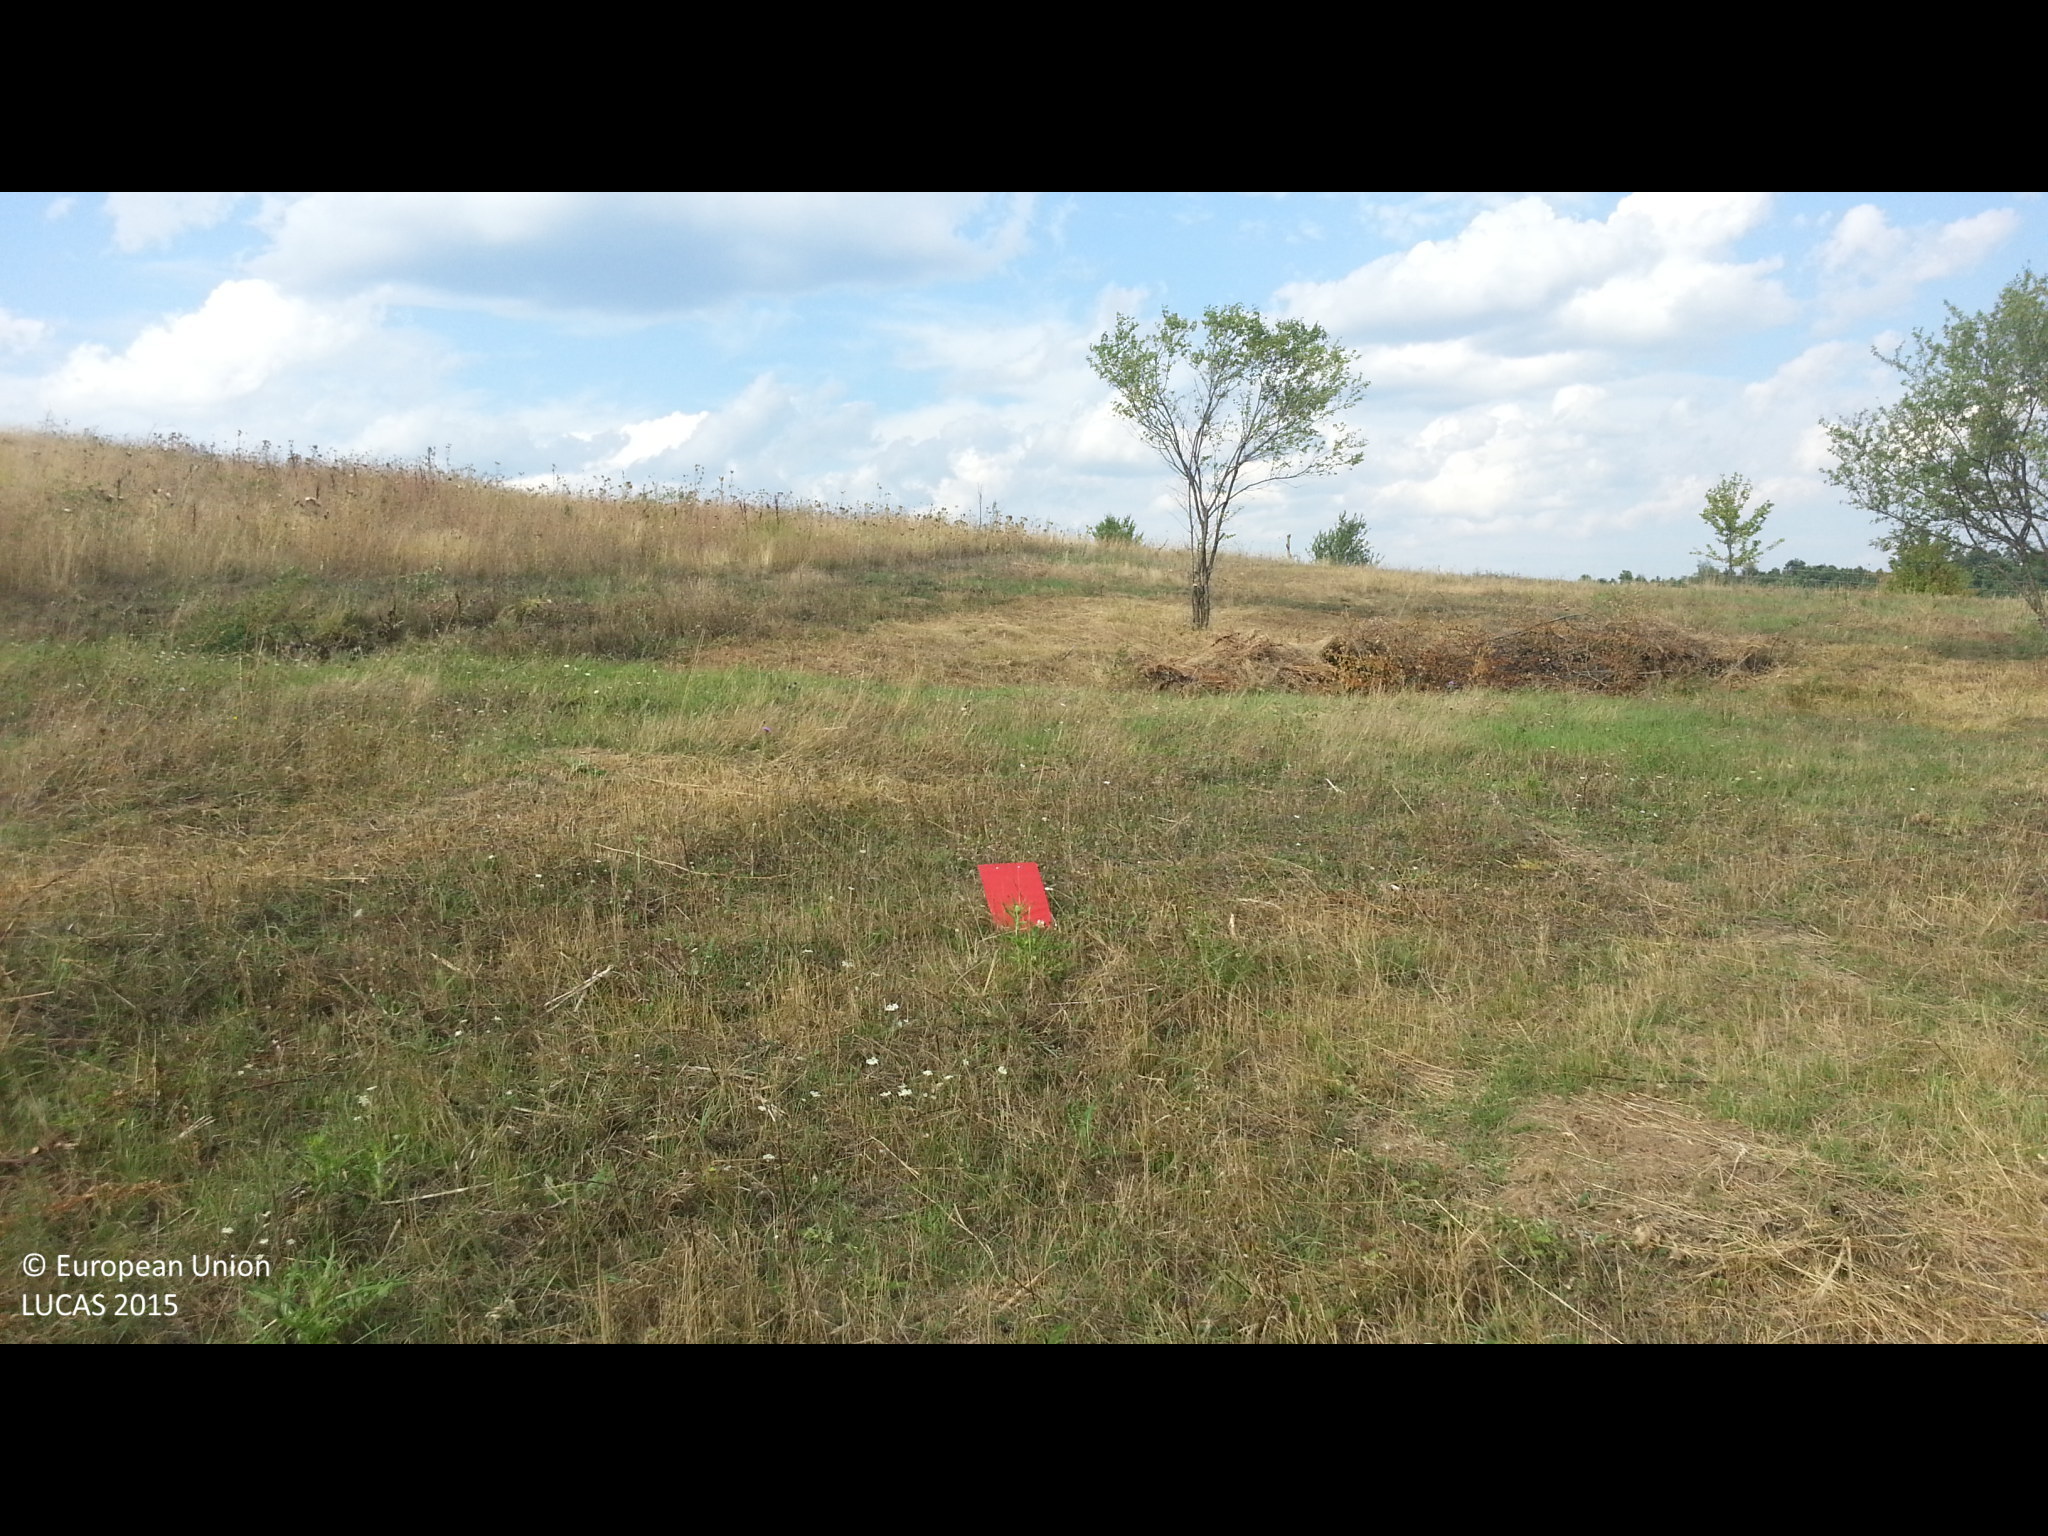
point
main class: Grassland
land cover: Grassland without tree/shrub cover
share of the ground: > 75 %
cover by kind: herbaceous plants 100 %
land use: Agriculture (excluding fallow land and kitchen gardens)
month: September
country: BG
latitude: 42.4649
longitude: 22.6099
